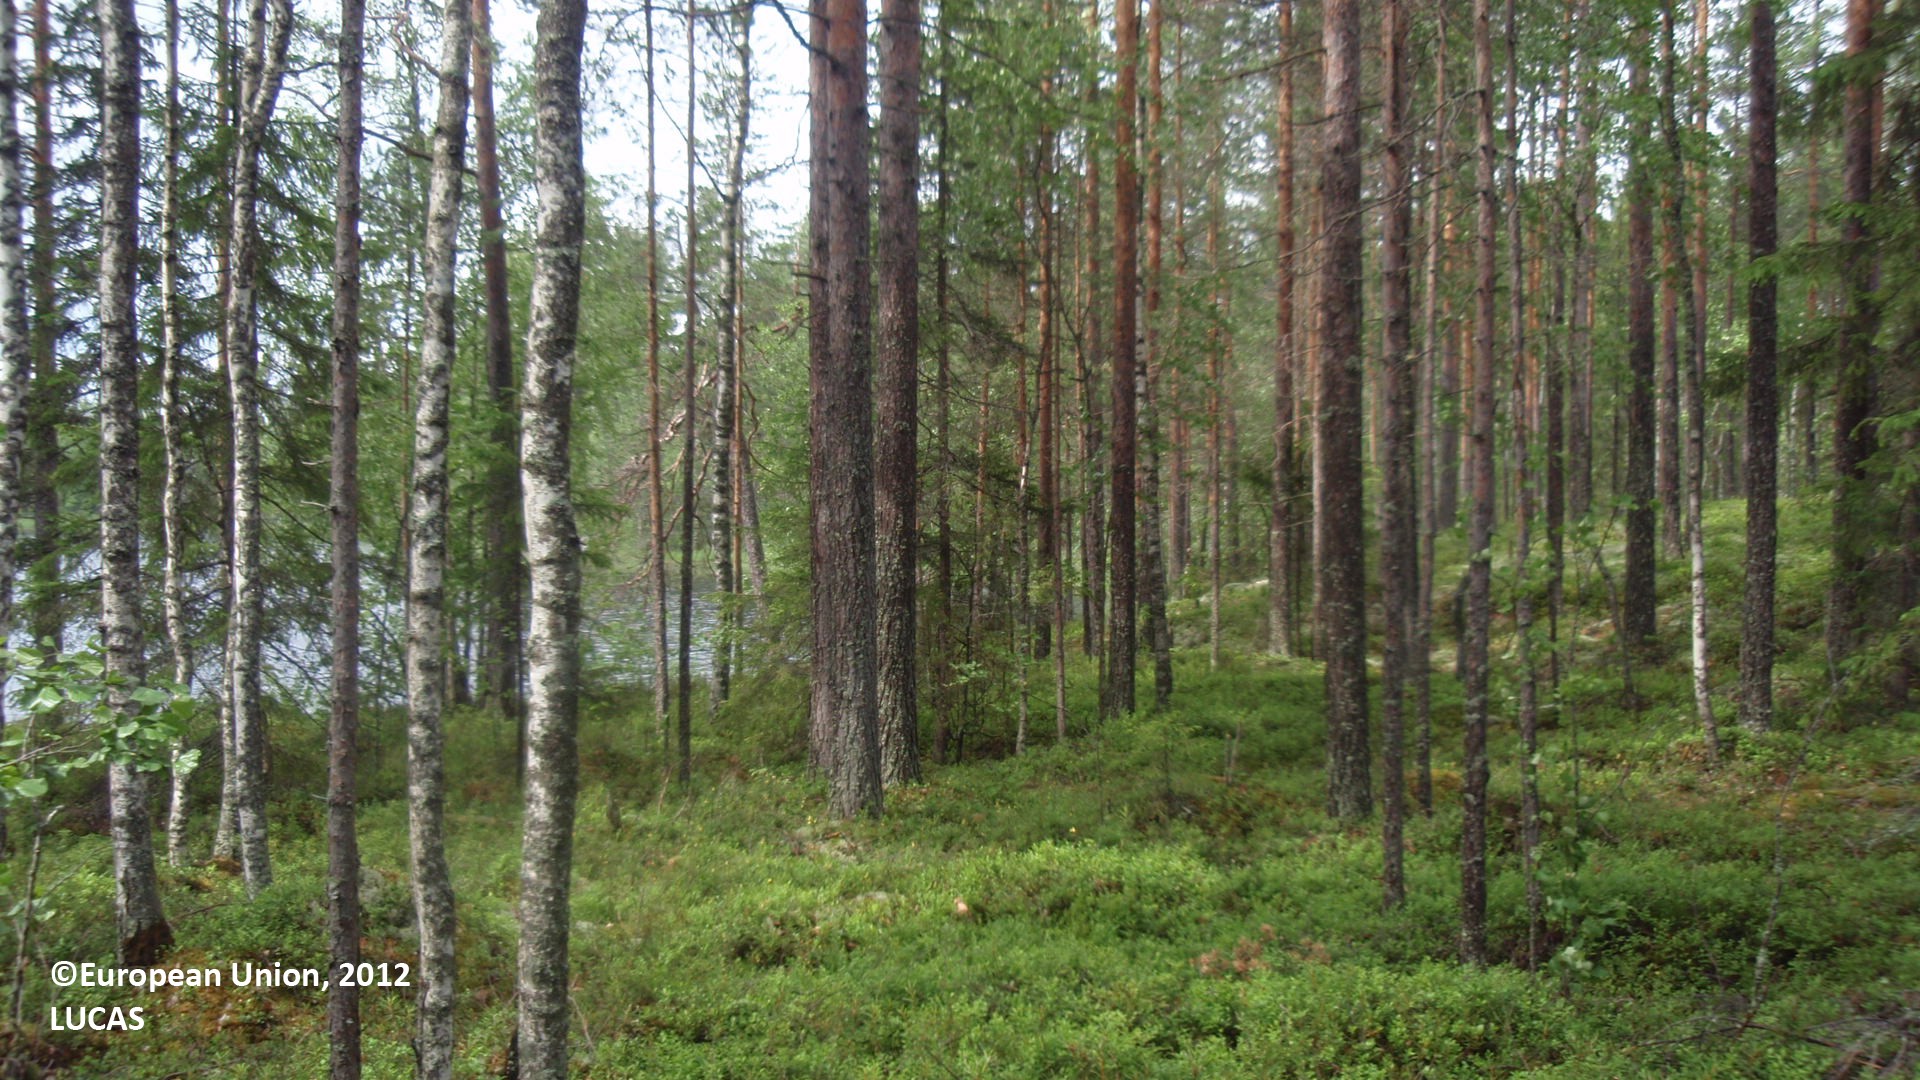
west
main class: Woodland
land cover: Pine dominated mixed woodland
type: boreal forest
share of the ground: 50 - 75 %
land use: Forestry
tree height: > 5 m
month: July
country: FI
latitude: 61.6277
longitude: 28.8422
